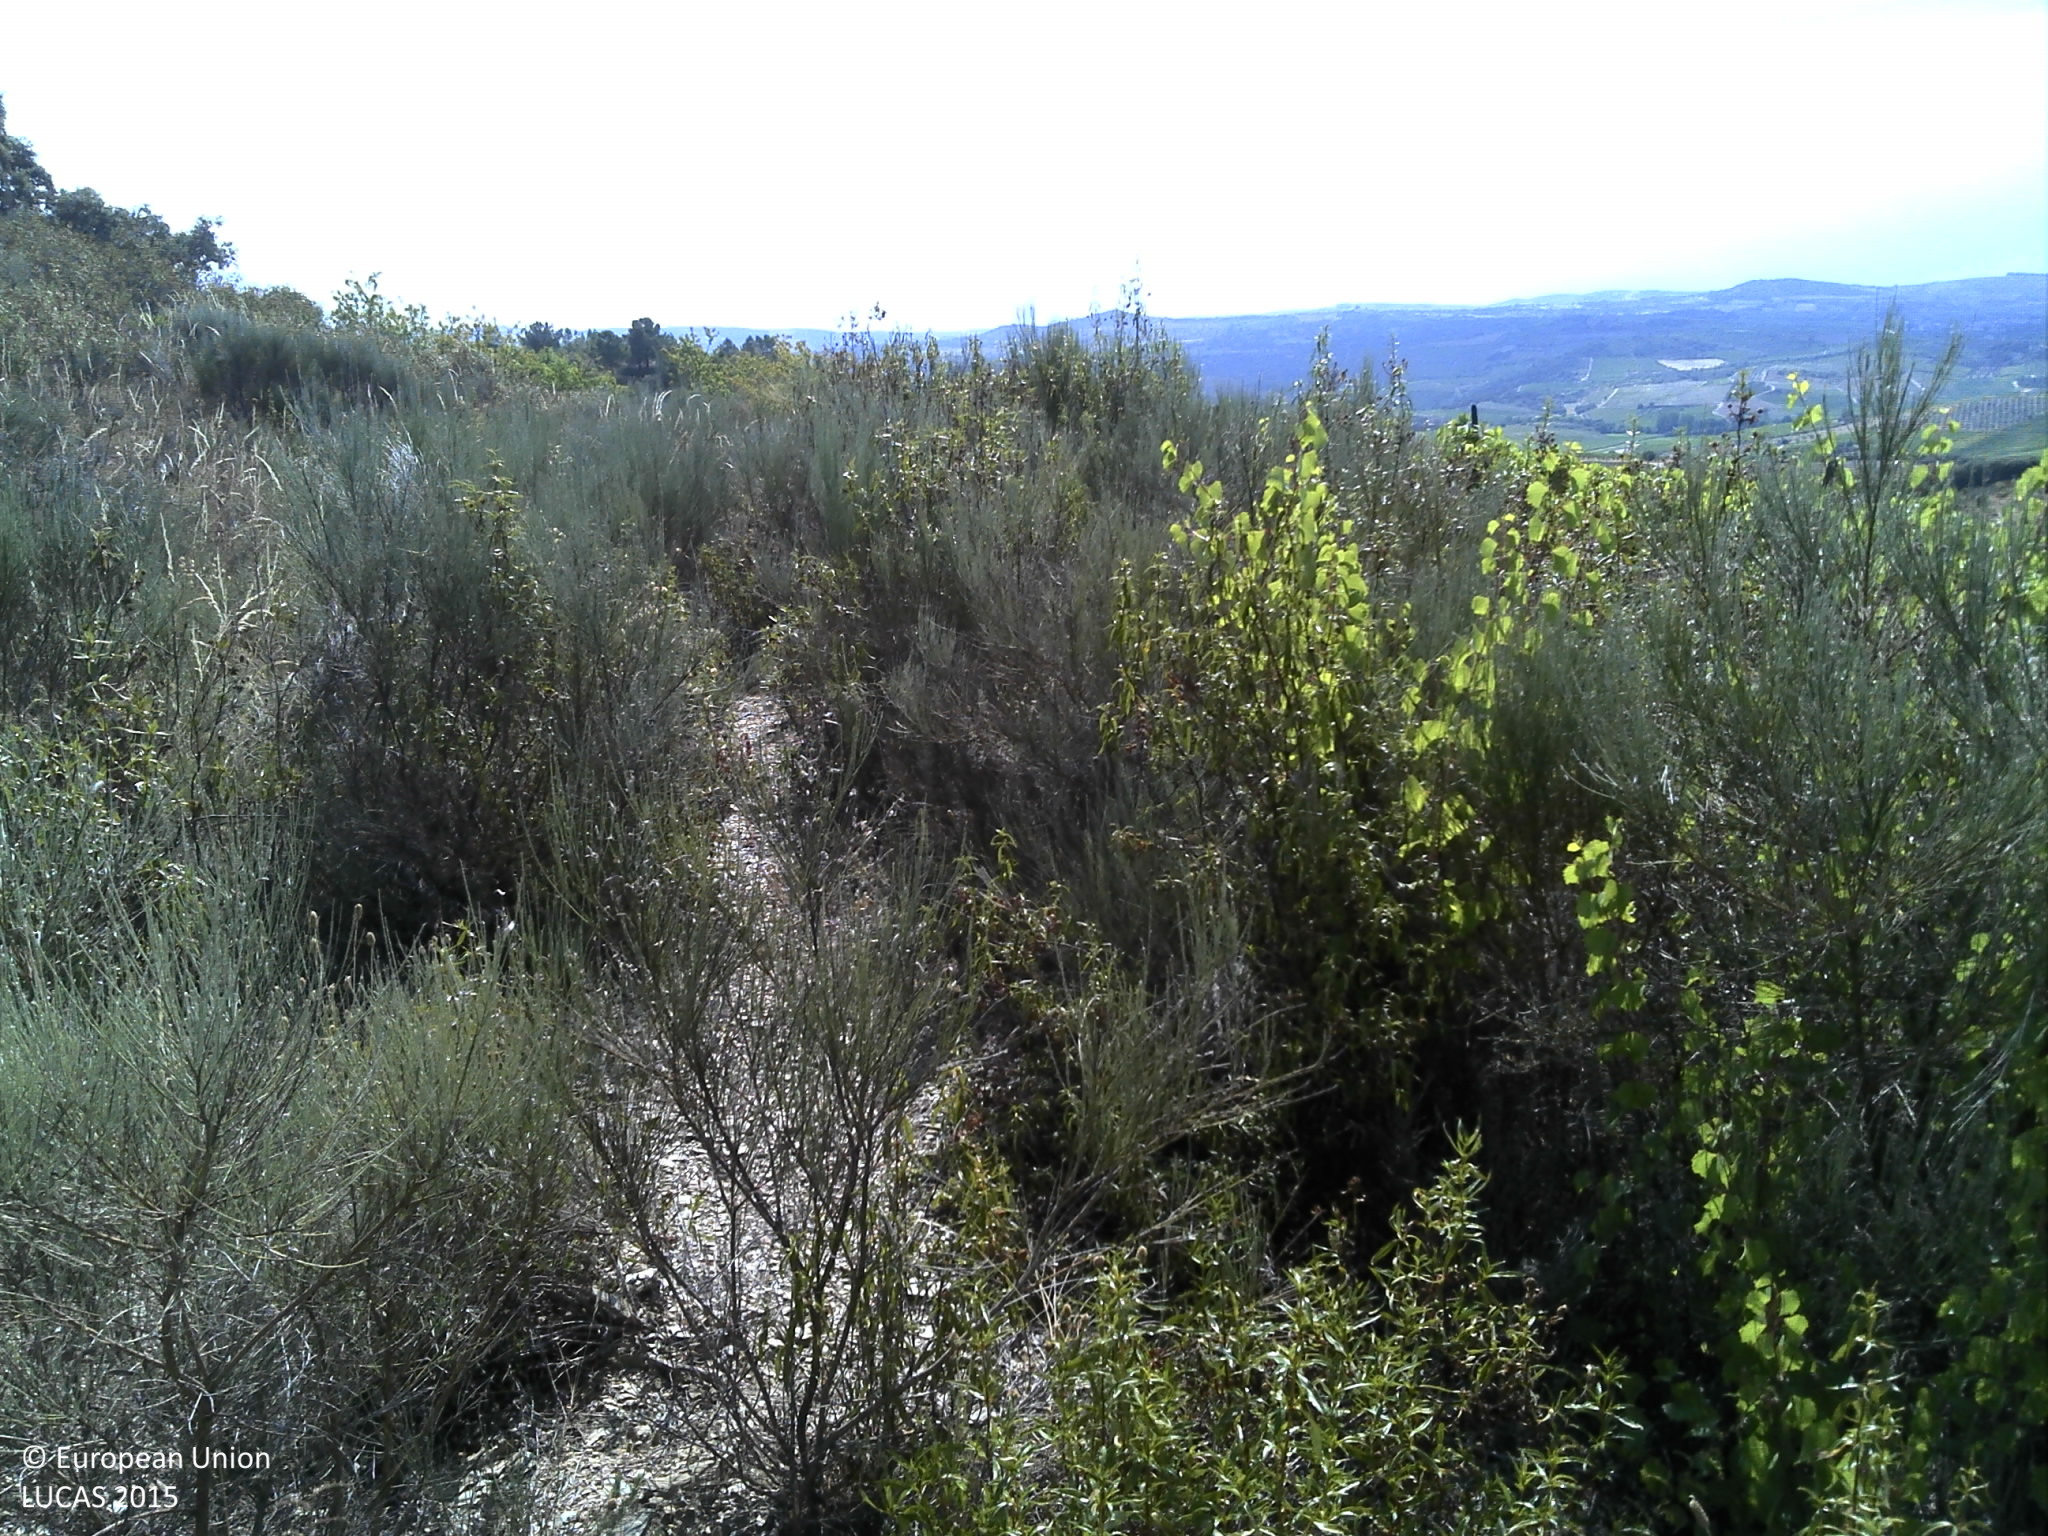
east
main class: Shrubland
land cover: Shrubland with sparse tree cover
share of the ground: > 75 %
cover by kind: shrubs 95 %, broadleaved forest trees 5 %
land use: Semi-natural and natural areas not in use
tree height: < 5 m
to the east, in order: Shrubland with sparse tree cover; Tracks; Nuts trees; Tracks; Grassland without tree/shrub cover; Nuts trees; Olive groves; Tracks; Nuts trees; Paved roads, cycling and walking lanes; Vineyards
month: July
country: PT
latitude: 41.0757
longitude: -7.3143
